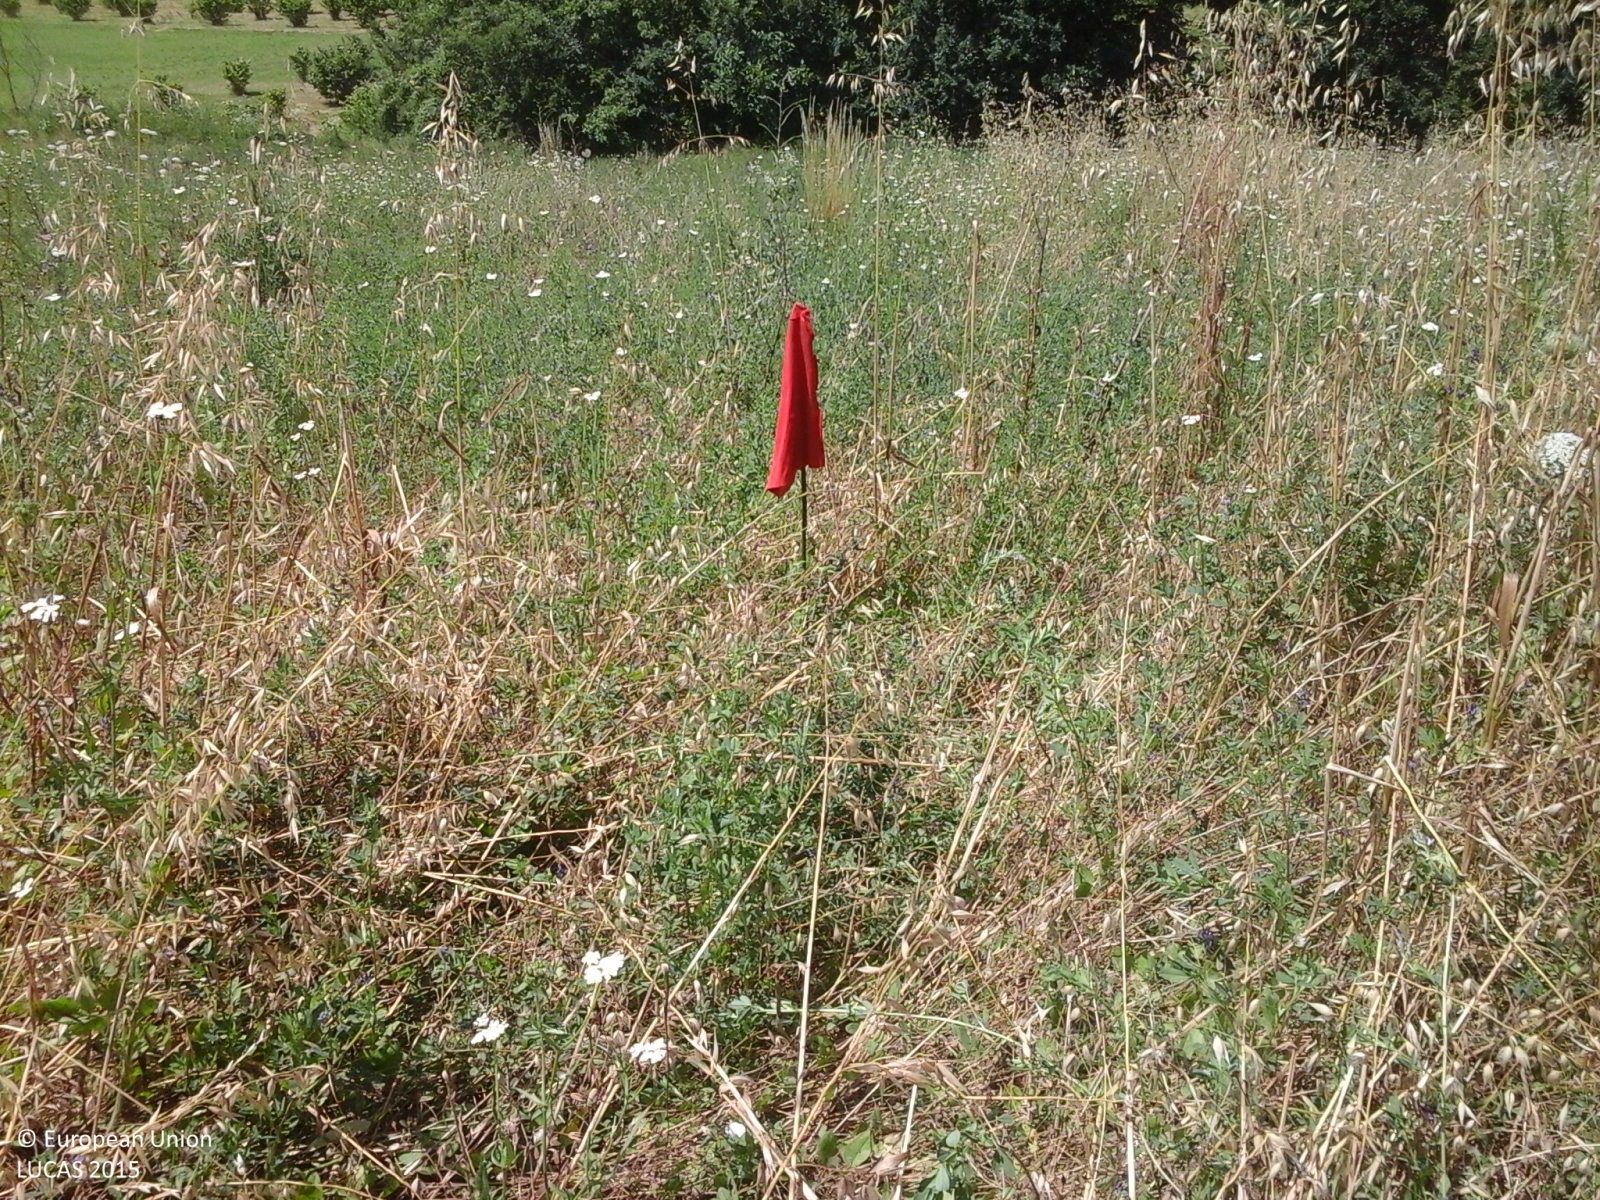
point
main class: Cropland
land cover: Temporary grasslands
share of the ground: > 75 %
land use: Agriculture (excluding fallow land and kitchen gardens)
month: June
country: IT
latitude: 45.0218
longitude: 8.2899
